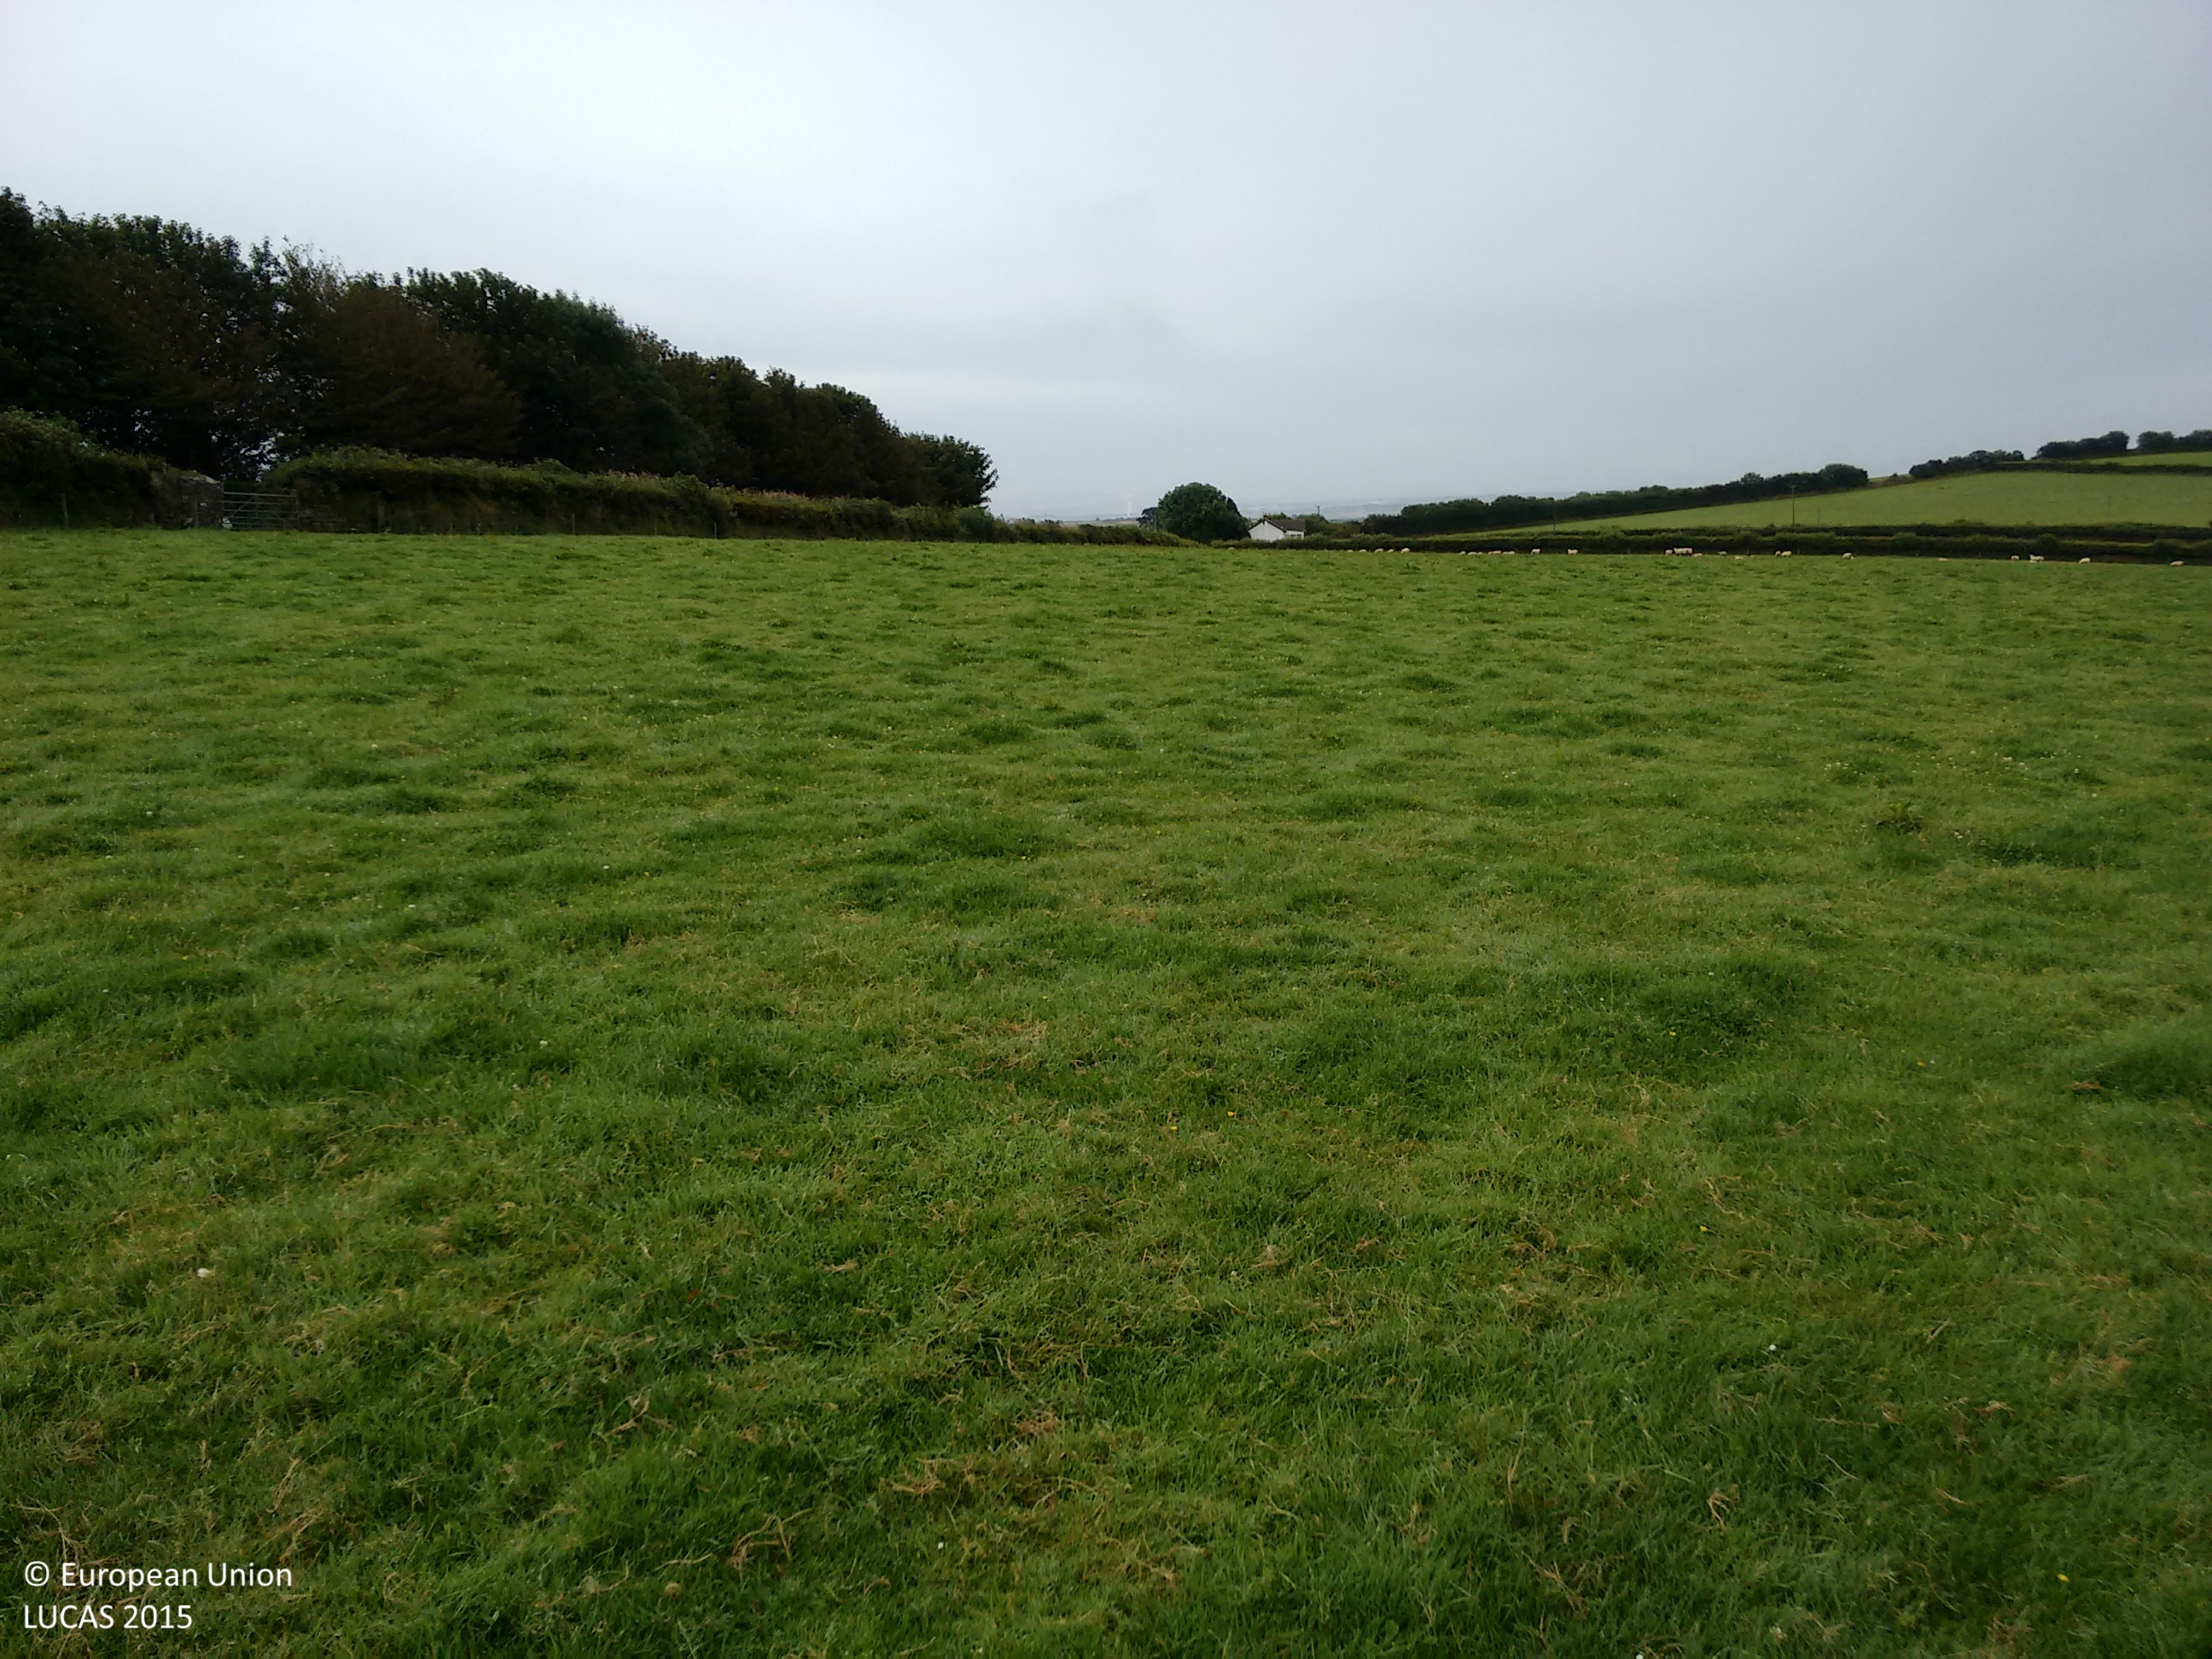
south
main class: Grassland
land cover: Grassland without tree/shrub cover
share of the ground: > 75 %
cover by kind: herbaceous plants 100 %
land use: Agriculture (excluding fallow land and kitchen gardens)
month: August
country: GB
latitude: 51.0871
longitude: -3.8393
